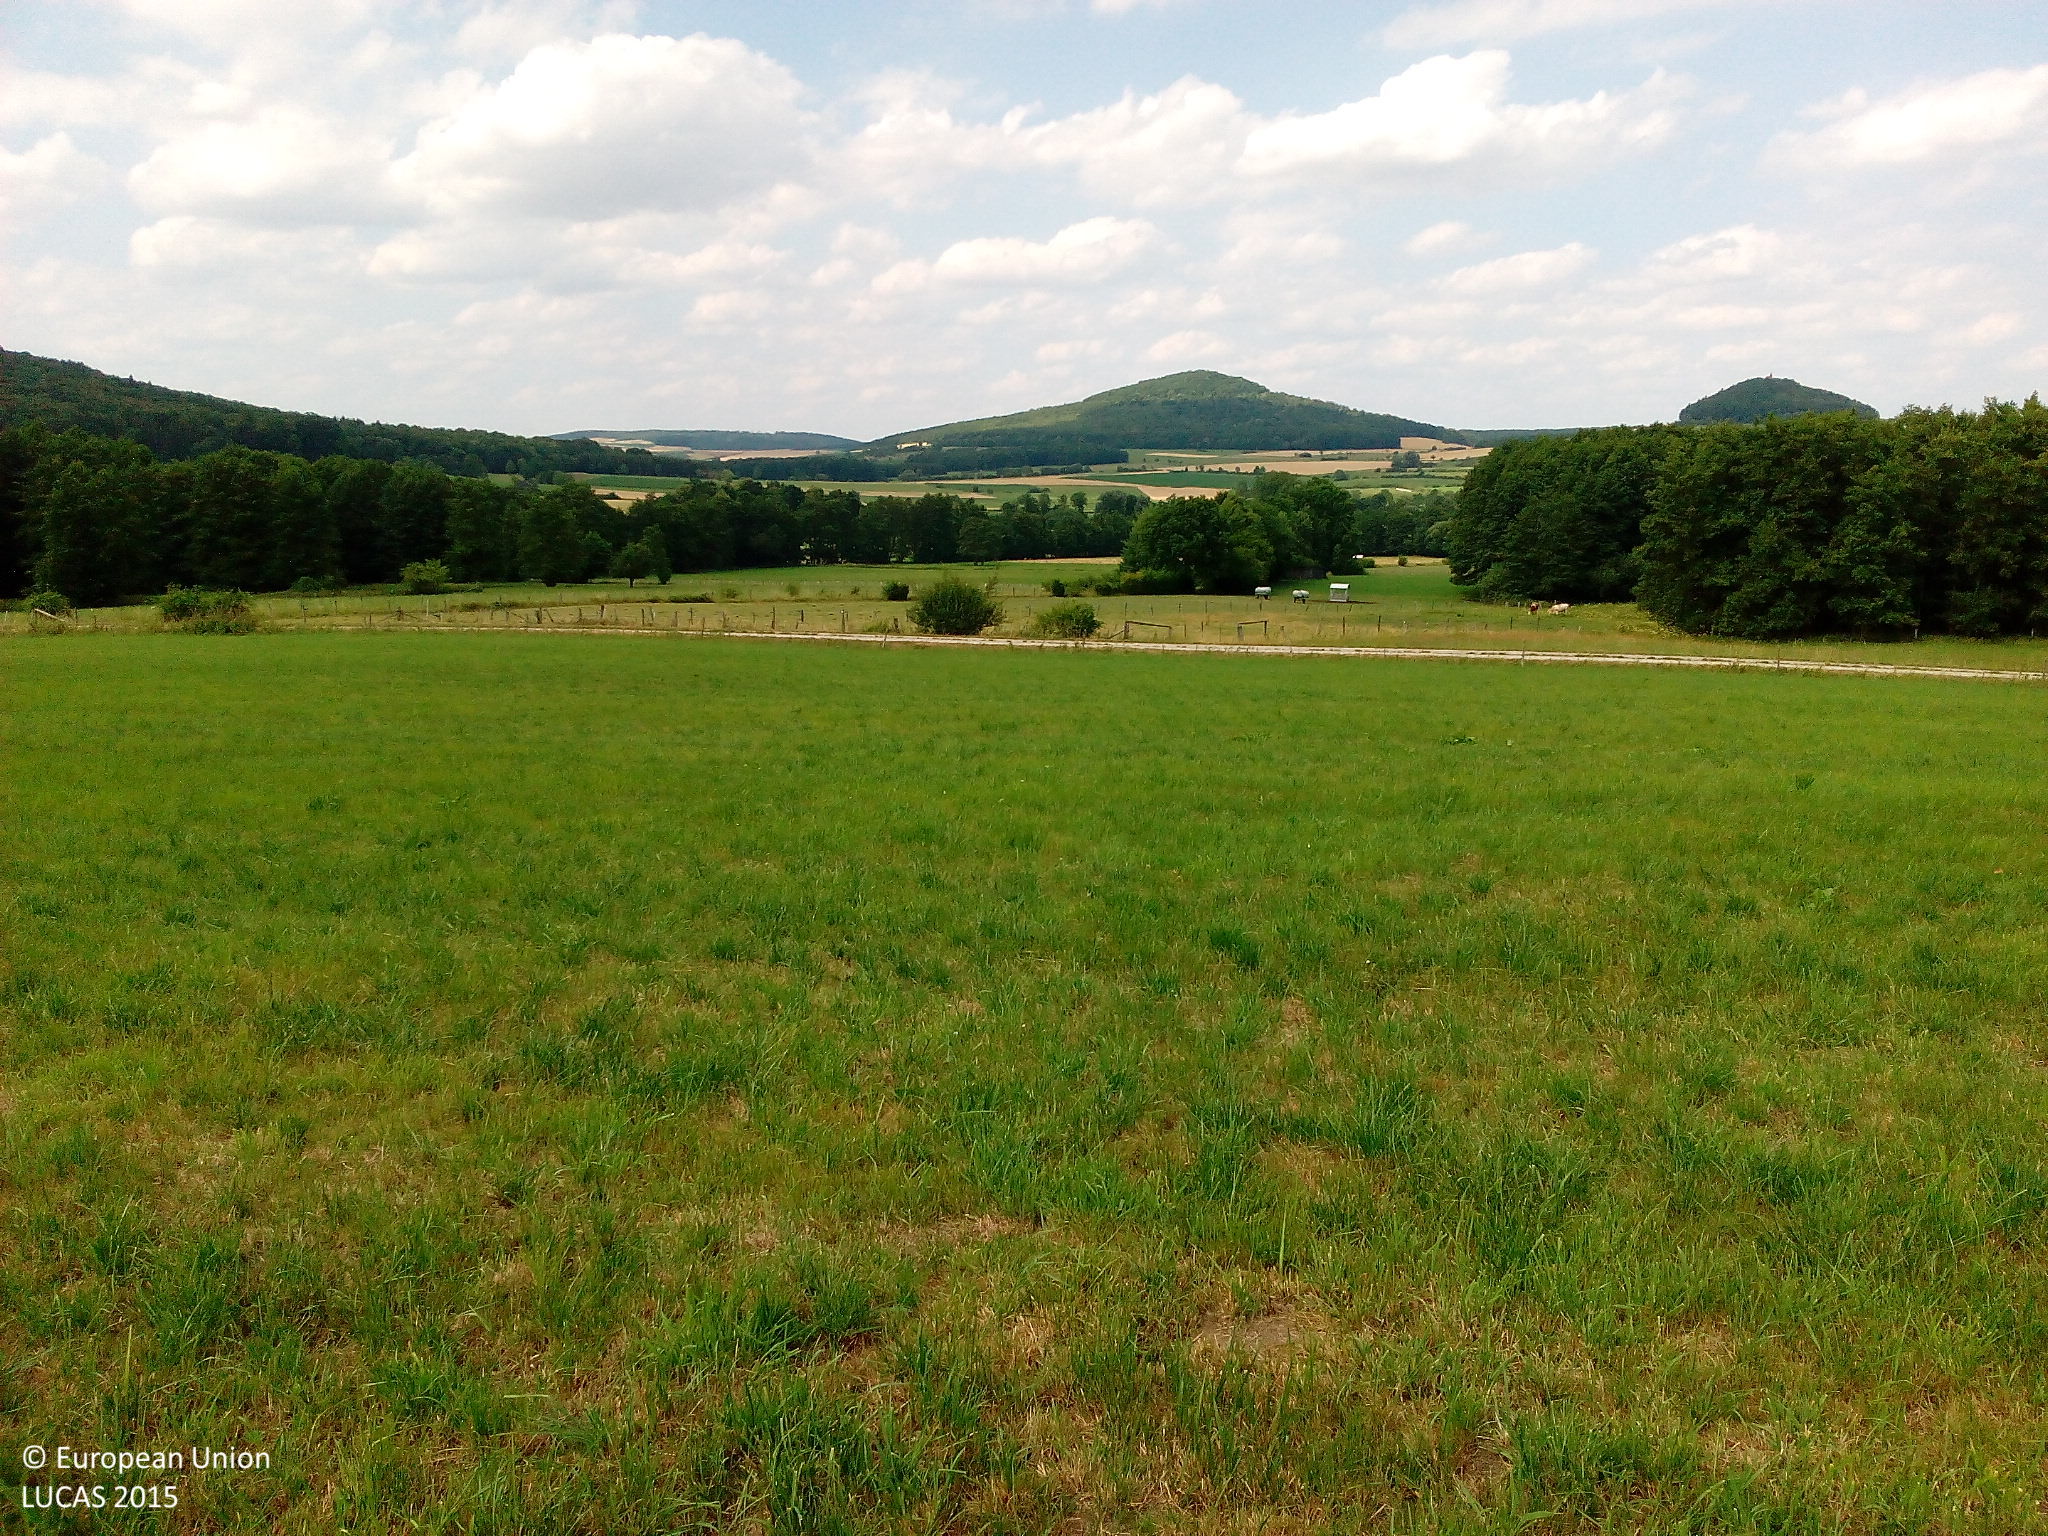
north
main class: Grassland
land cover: Grassland without tree/shrub cover
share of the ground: > 75 %
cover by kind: herbaceous plants 100 %
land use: Agriculture (excluding fallow land and kitchen gardens)
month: July
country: DE
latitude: 50.7056
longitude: 9.8726
